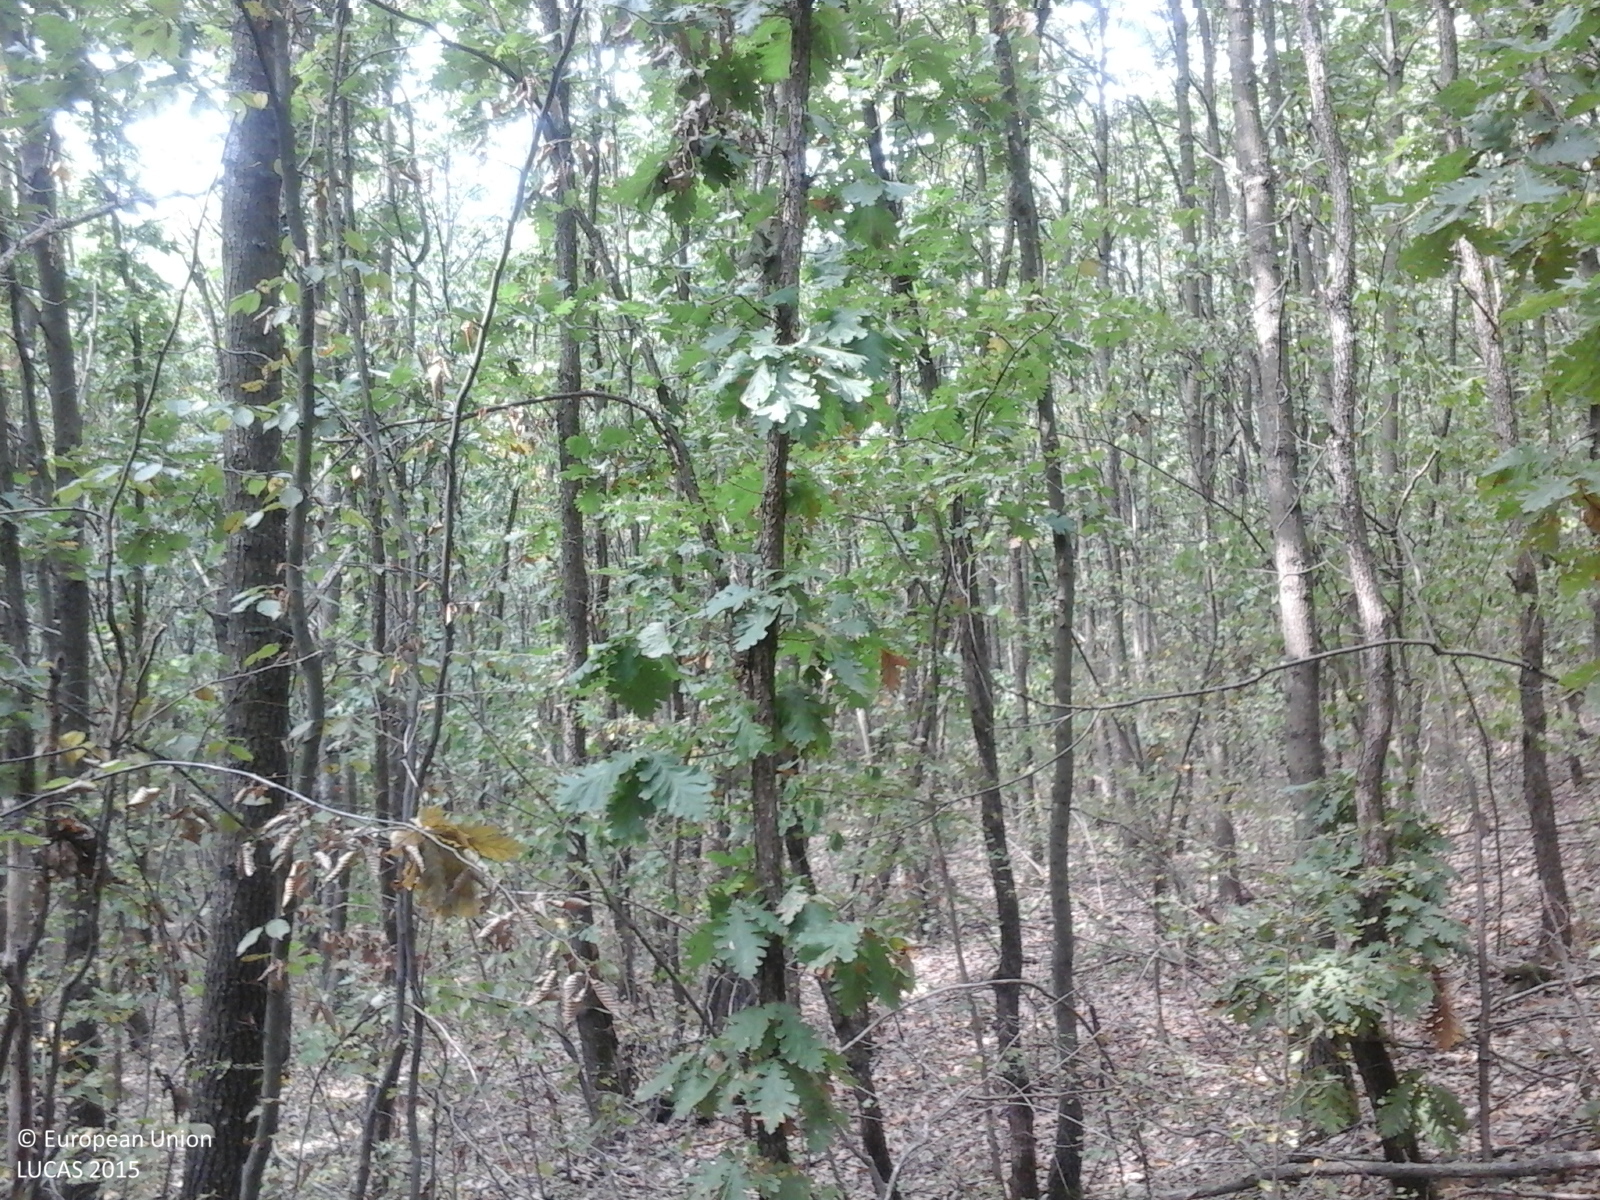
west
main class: Woodland
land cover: Broadleaved woodland
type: acidophilous oak and oak-birch forest
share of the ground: > 75 %
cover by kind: broadleaved forest trees 100 %
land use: Forestry
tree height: > 5 m
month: September
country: RO
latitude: 45.6946
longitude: 21.9695
